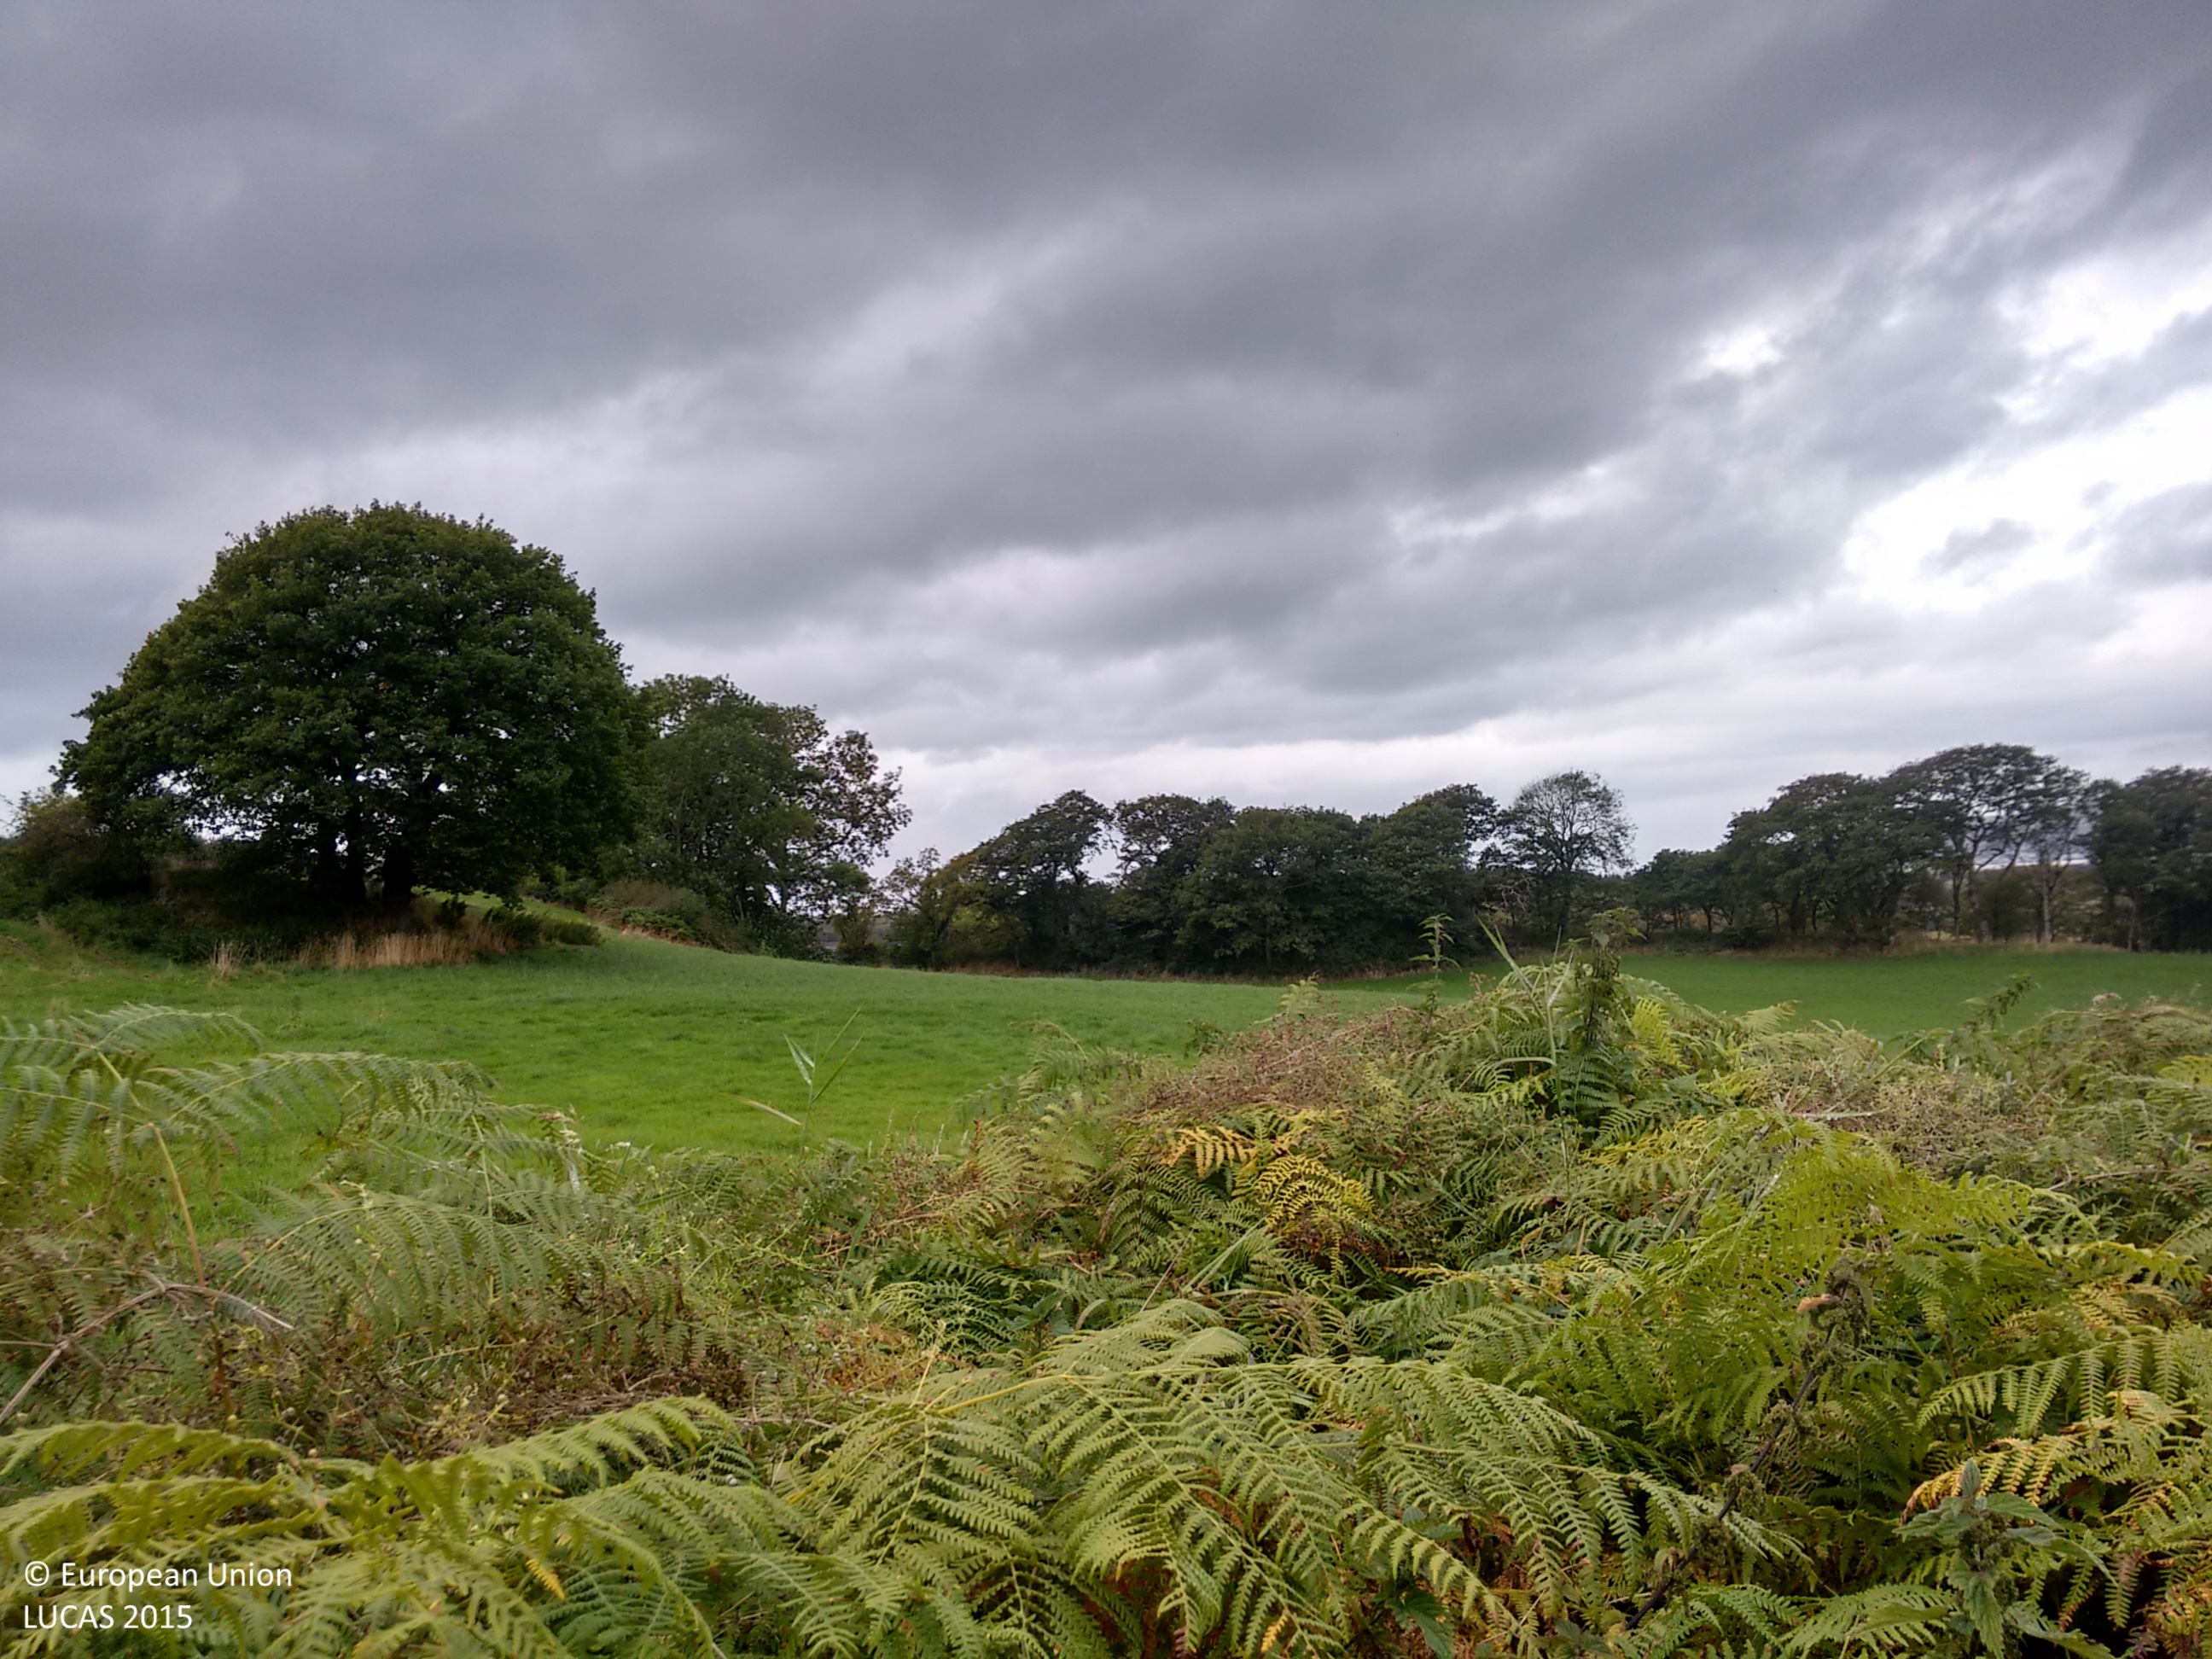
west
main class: Grassland
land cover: Grassland with sparse tree/shrub cover
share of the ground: > 75 %
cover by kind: herbaceous plants 95 %, broadleaved forest trees 5 %
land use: Agriculture (excluding fallow land and kitchen gardens)
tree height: > 5 m
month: October
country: GB
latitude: 52.5114
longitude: -3.9890
